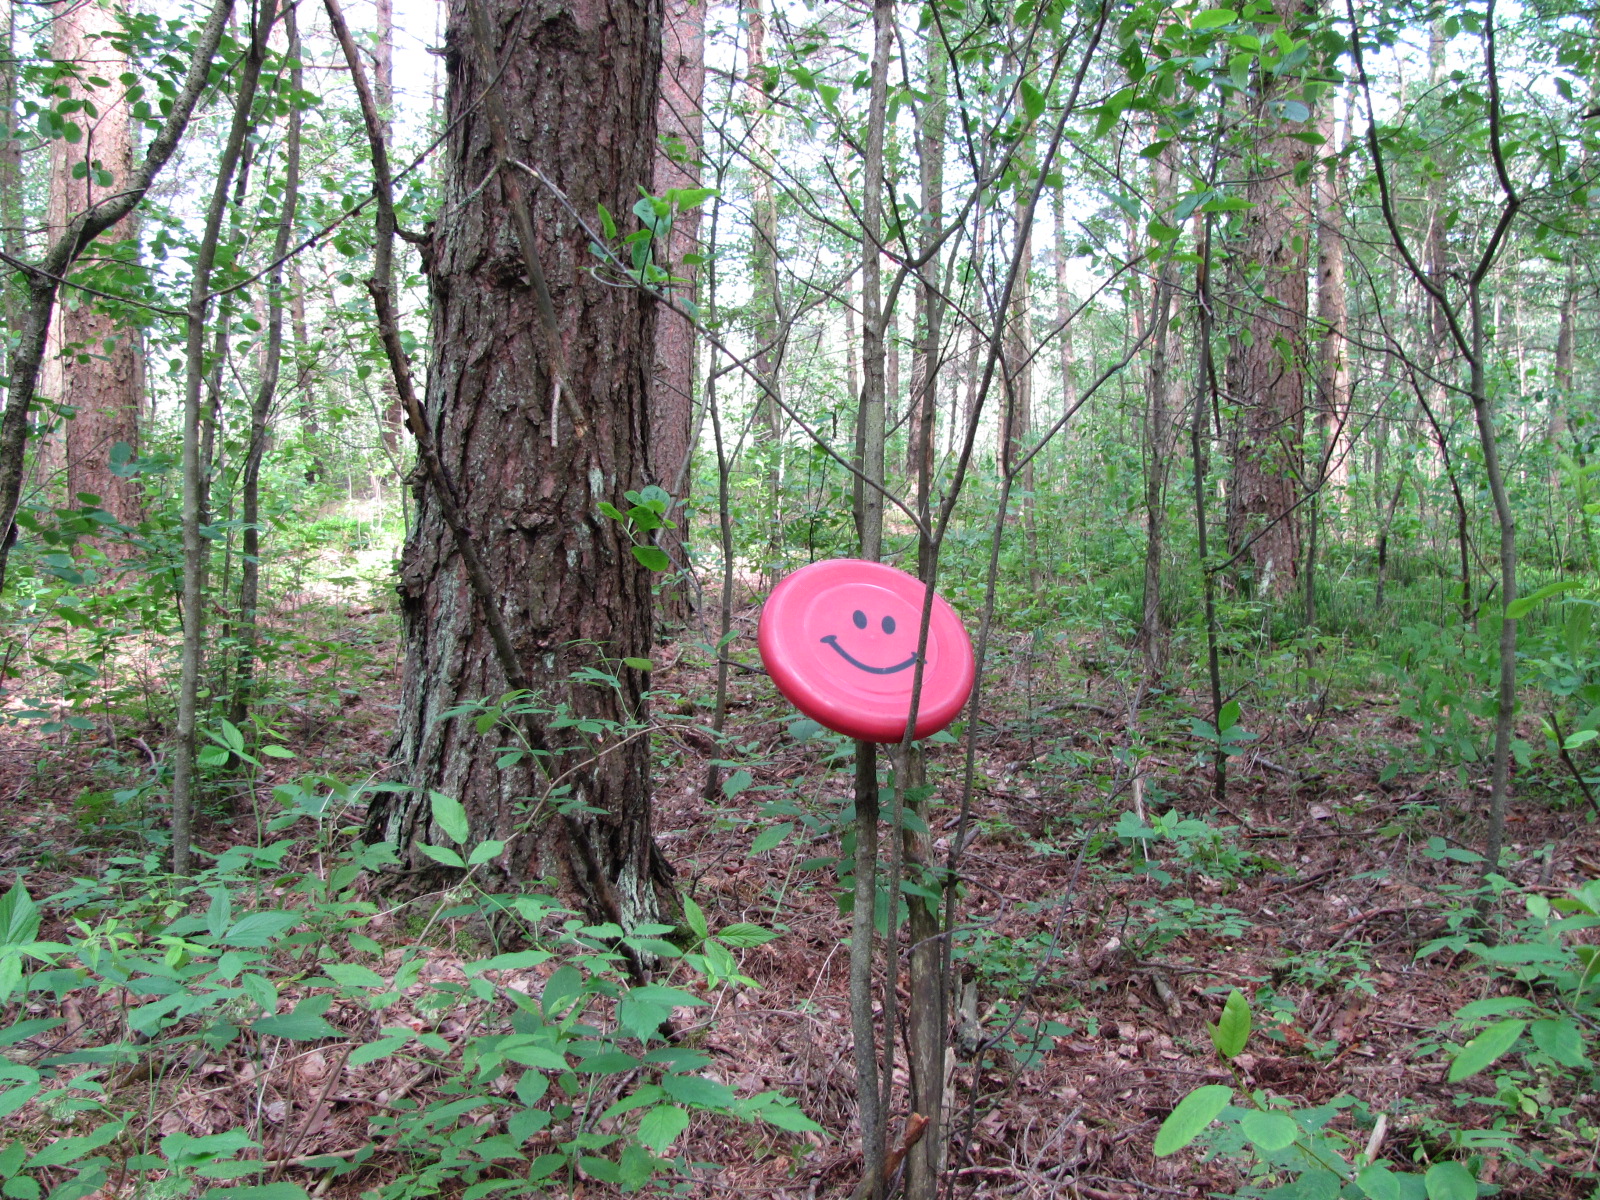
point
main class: Woodland
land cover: Pine dominated mixed woodland
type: mire and swamp forests
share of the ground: > 75 %
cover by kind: coniferous forest trees 70 %, broadleaved forest trees 30 %
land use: Forestry
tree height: > 5 m
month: June
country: LV
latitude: 56.8726
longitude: 23.8789
